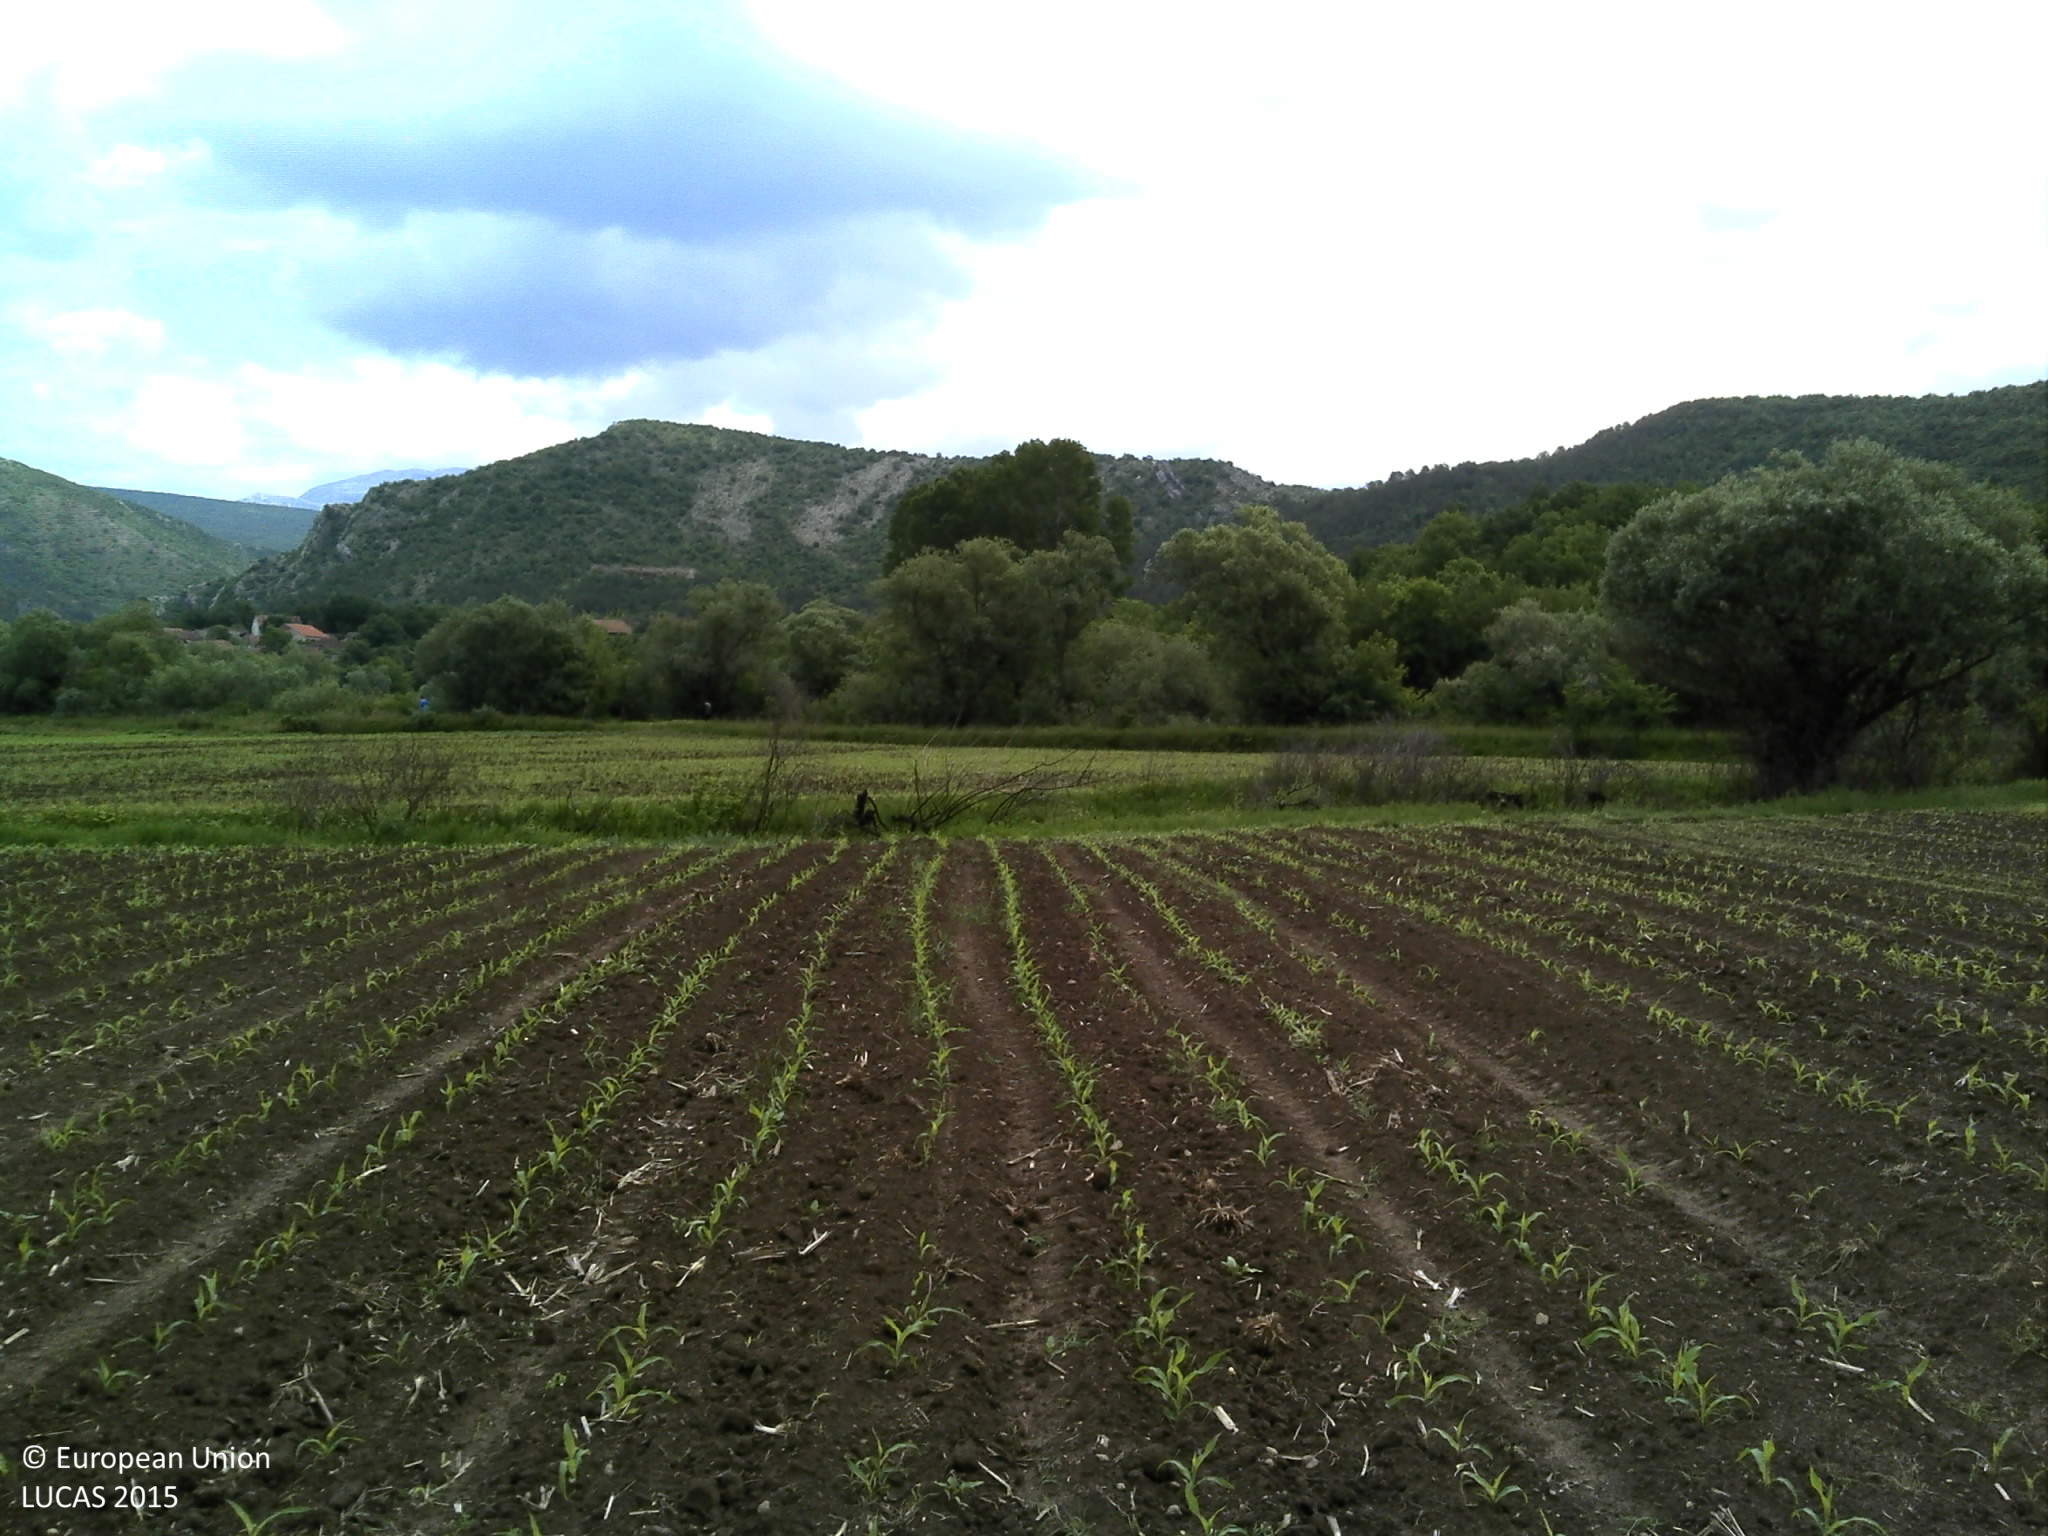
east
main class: Cropland
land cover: Maize
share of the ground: < 10 %
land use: Agriculture (excluding fallow land and kitchen gardens)
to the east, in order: Maize; Single bushes/trees; Ditches and canals; Maize; Tracks; Broadleaved woodland; Inland fresh running water; Lines of trees; Grassland with sparse tree/shrub cover; Broadleaved woodland
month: May
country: HR
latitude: 44.0374
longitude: 16.2194
